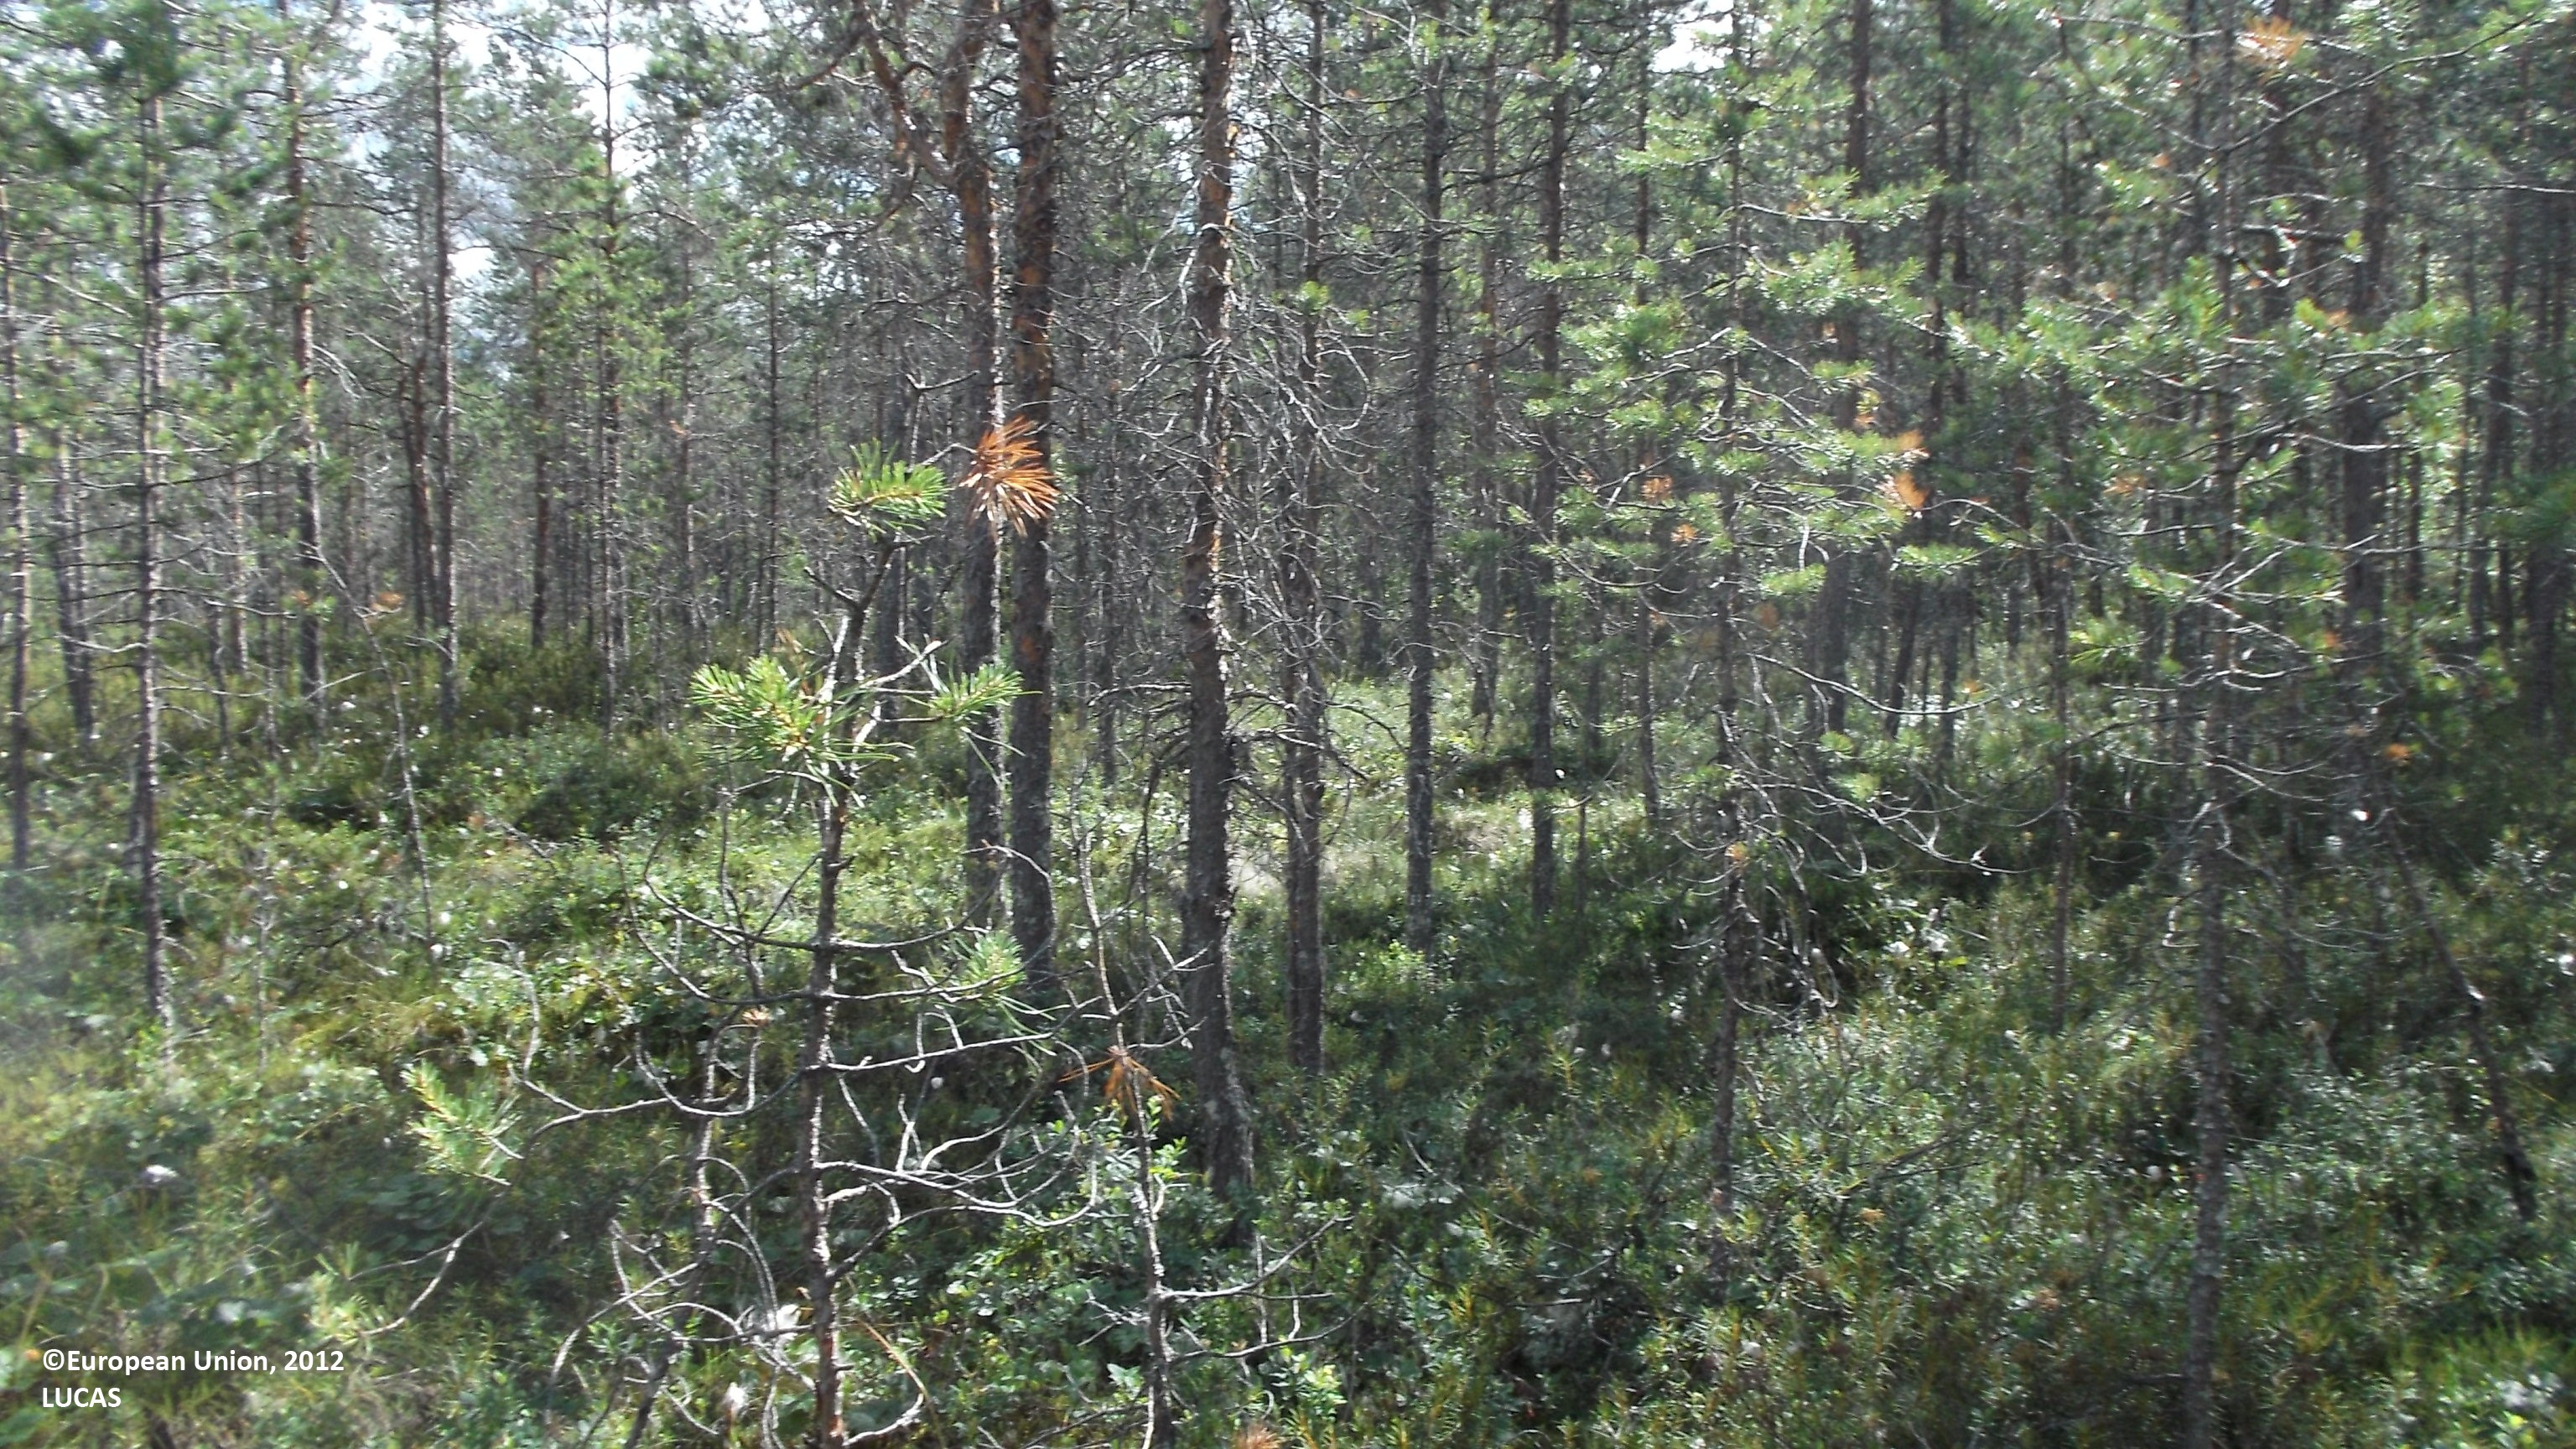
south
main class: Woodland
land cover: Pine dominated coniferous woodland
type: mire and swamp forests
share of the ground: 50 - 75 %
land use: Forestry
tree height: < 5 m
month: July
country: FI
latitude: 63.2730
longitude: 23.8415
